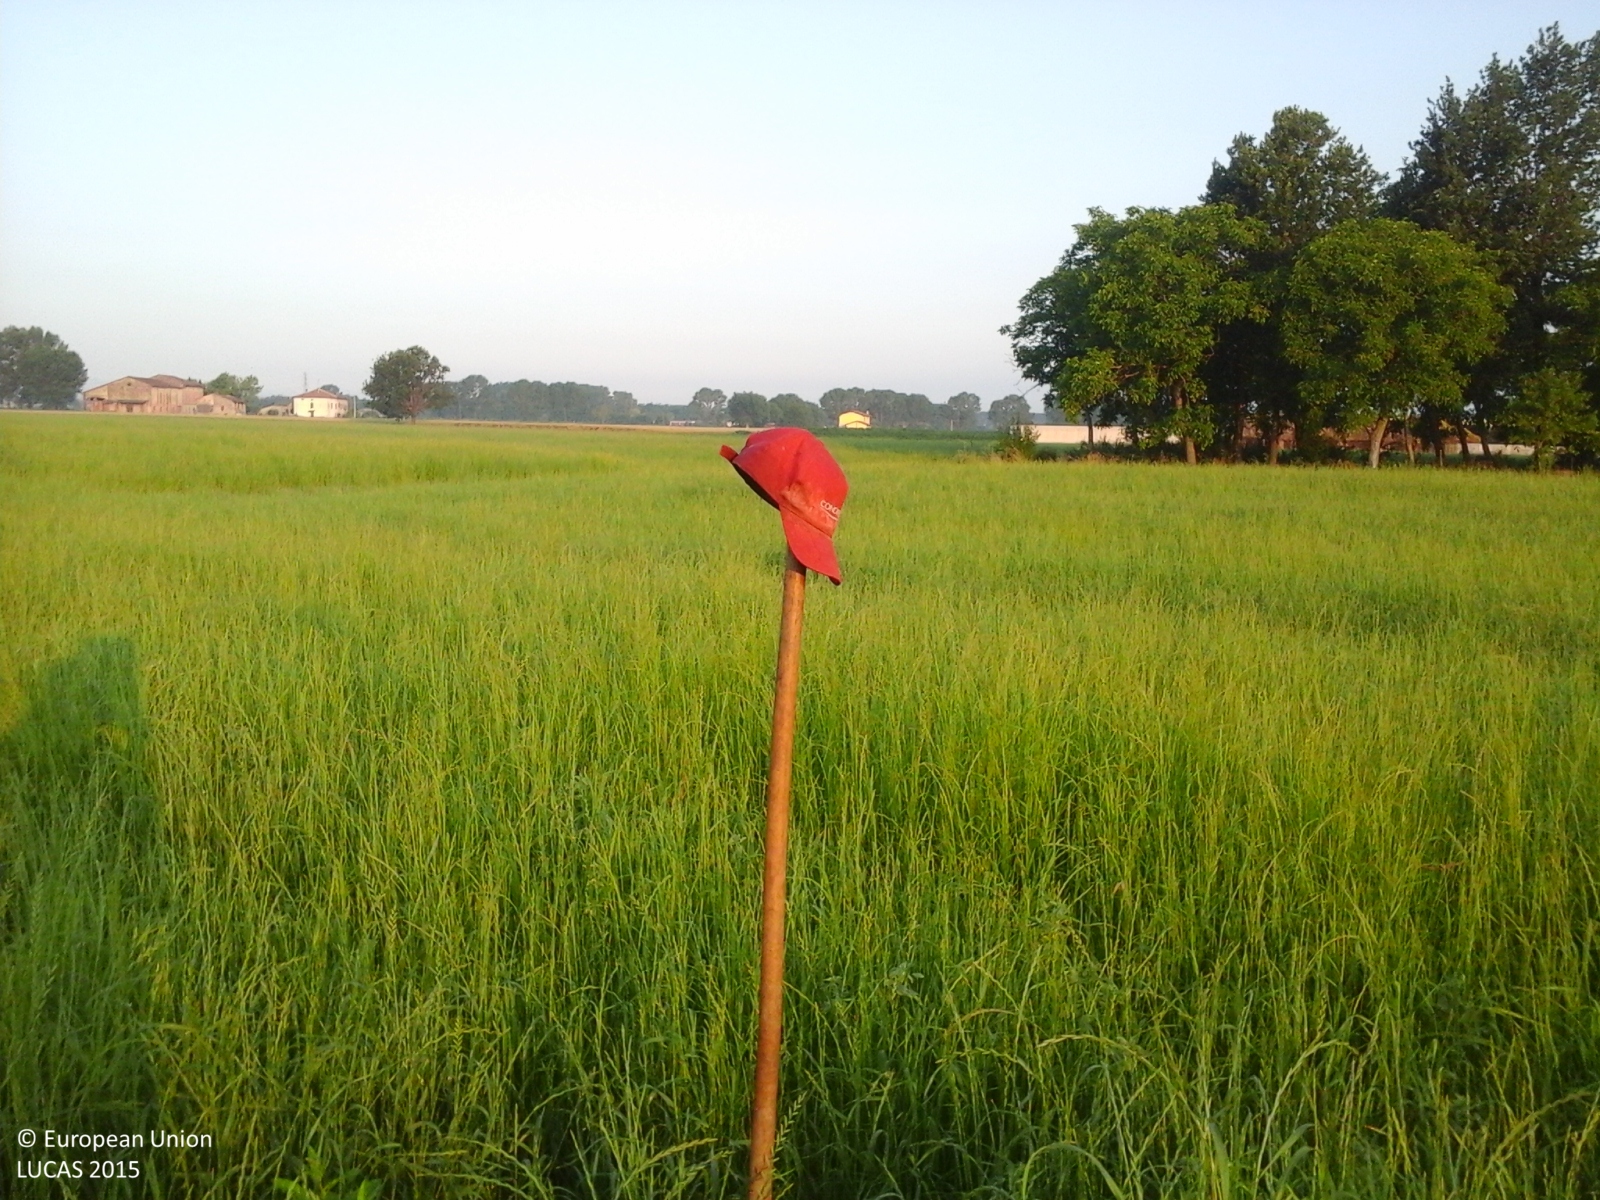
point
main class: Cropland
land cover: Temporary grasslands
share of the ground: > 75 %
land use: Agriculture (excluding fallow land and kitchen gardens)
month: June
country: IT
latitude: 44.9276
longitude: 10.0126
